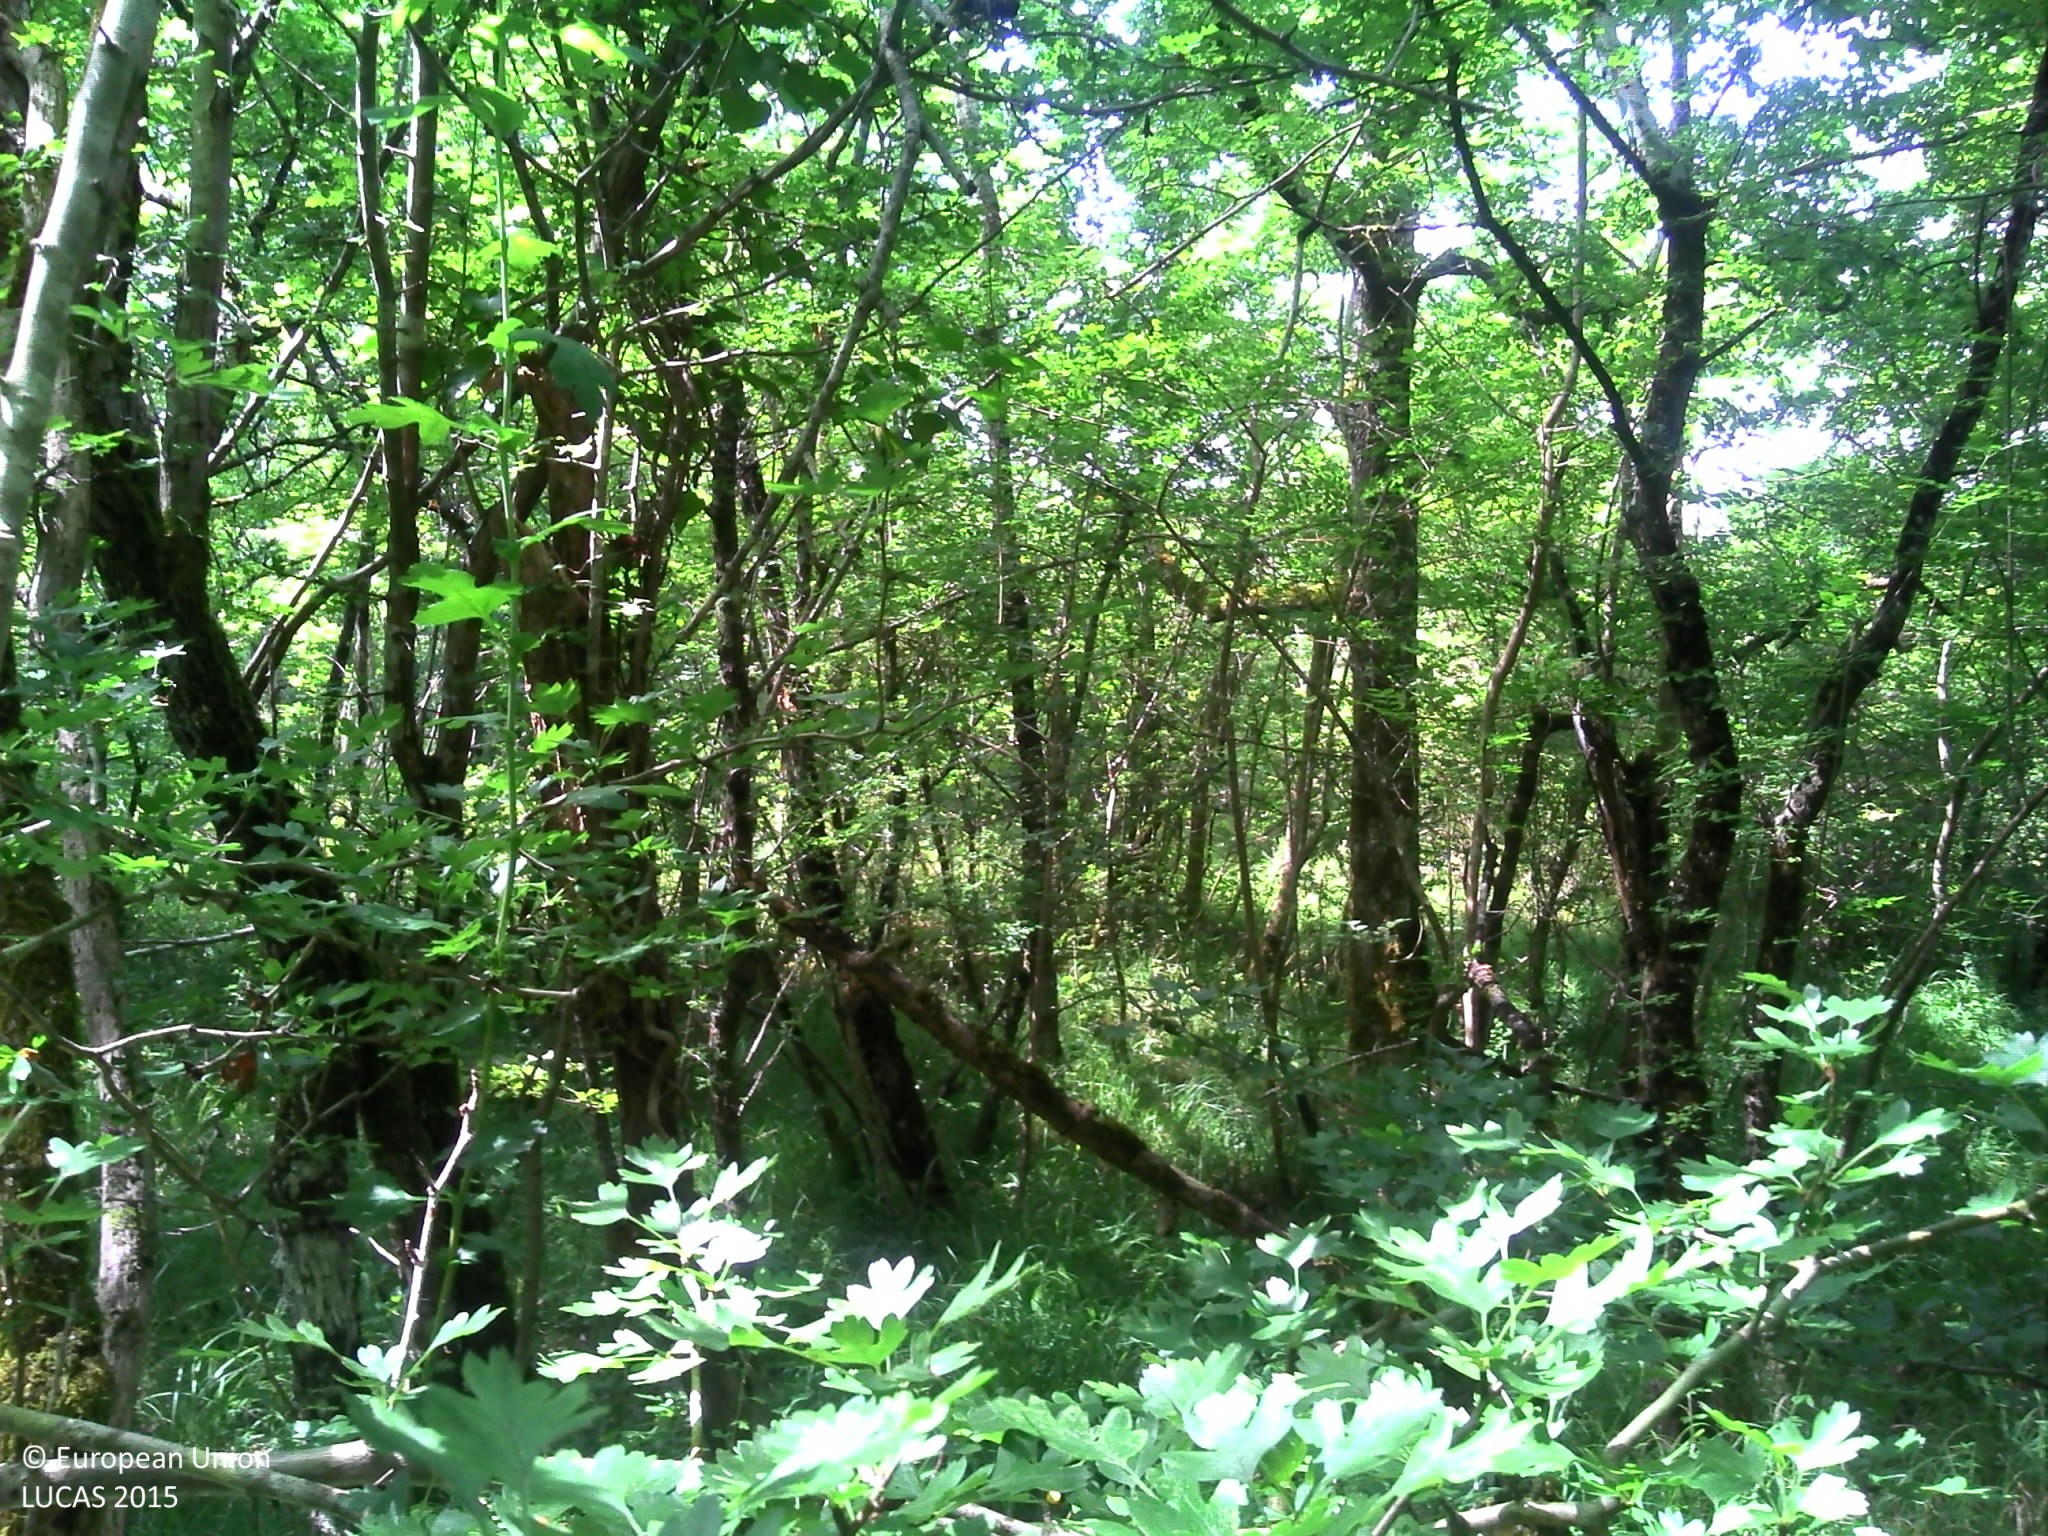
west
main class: Woodland
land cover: Broadleaved woodland
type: mesophytic deciduous forest
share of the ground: > 75 %
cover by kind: broadleaved forest trees 80 %, herbaceous plants 15 %, shrubs 5 %
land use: Forestry
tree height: > 5 m
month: June
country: FR
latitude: 45.7927
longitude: -0.8976
